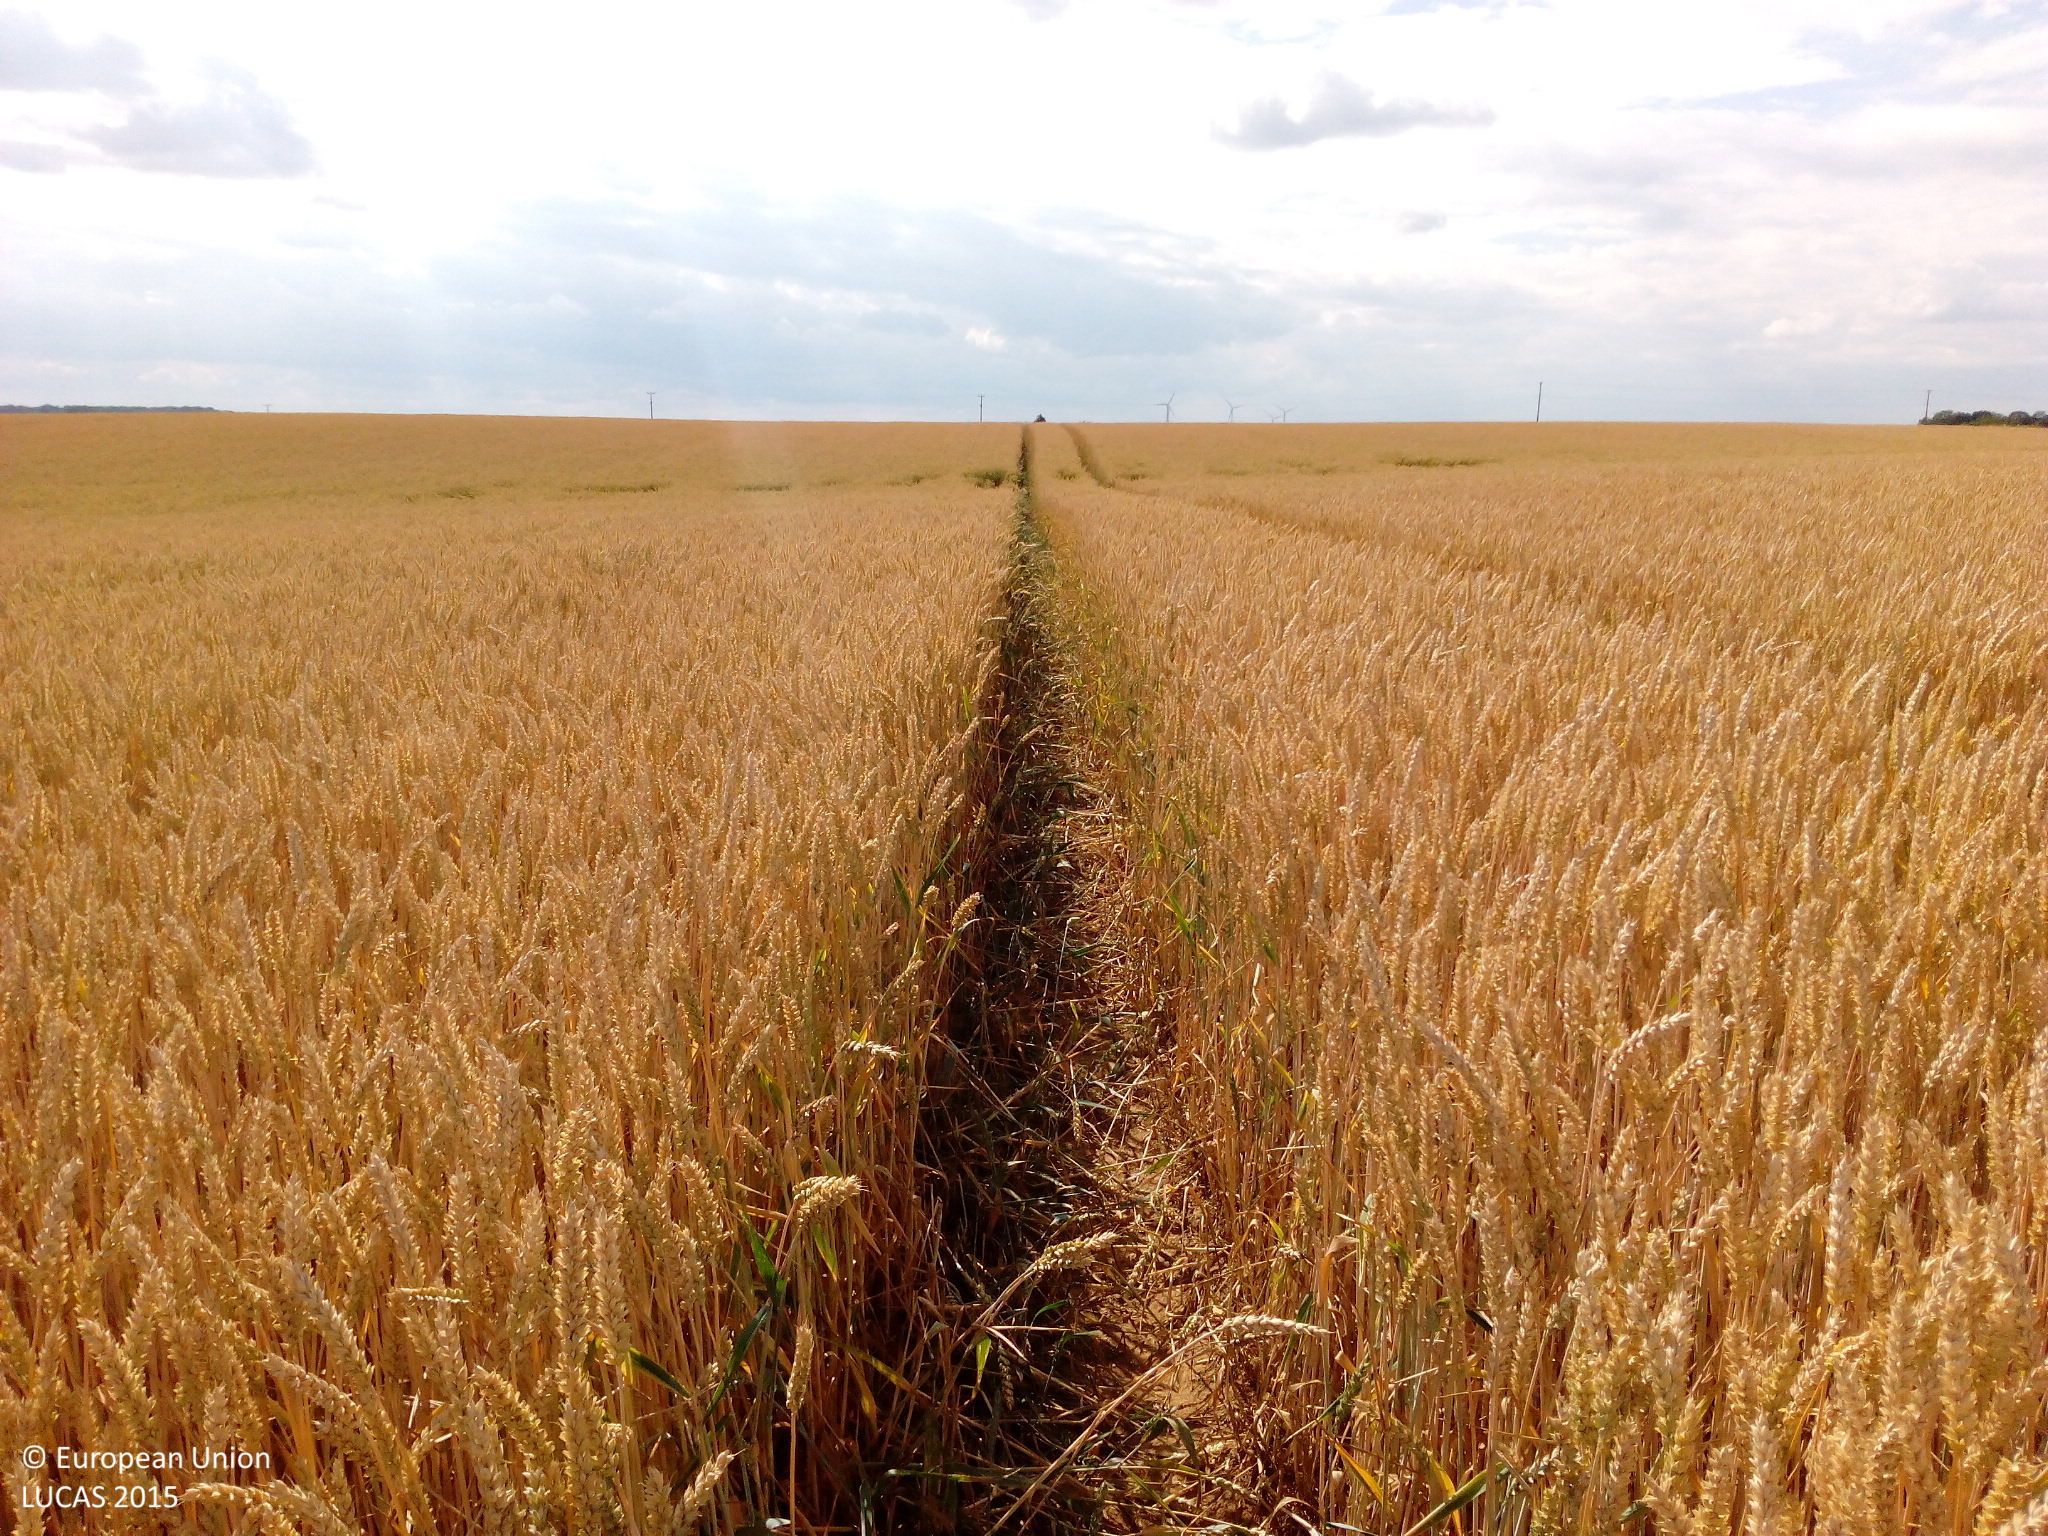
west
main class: Cropland
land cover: Common wheat
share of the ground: > 75 %
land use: Agriculture (excluding fallow land and kitchen gardens)
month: July
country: DE
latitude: 49.6807
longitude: 9.9584
